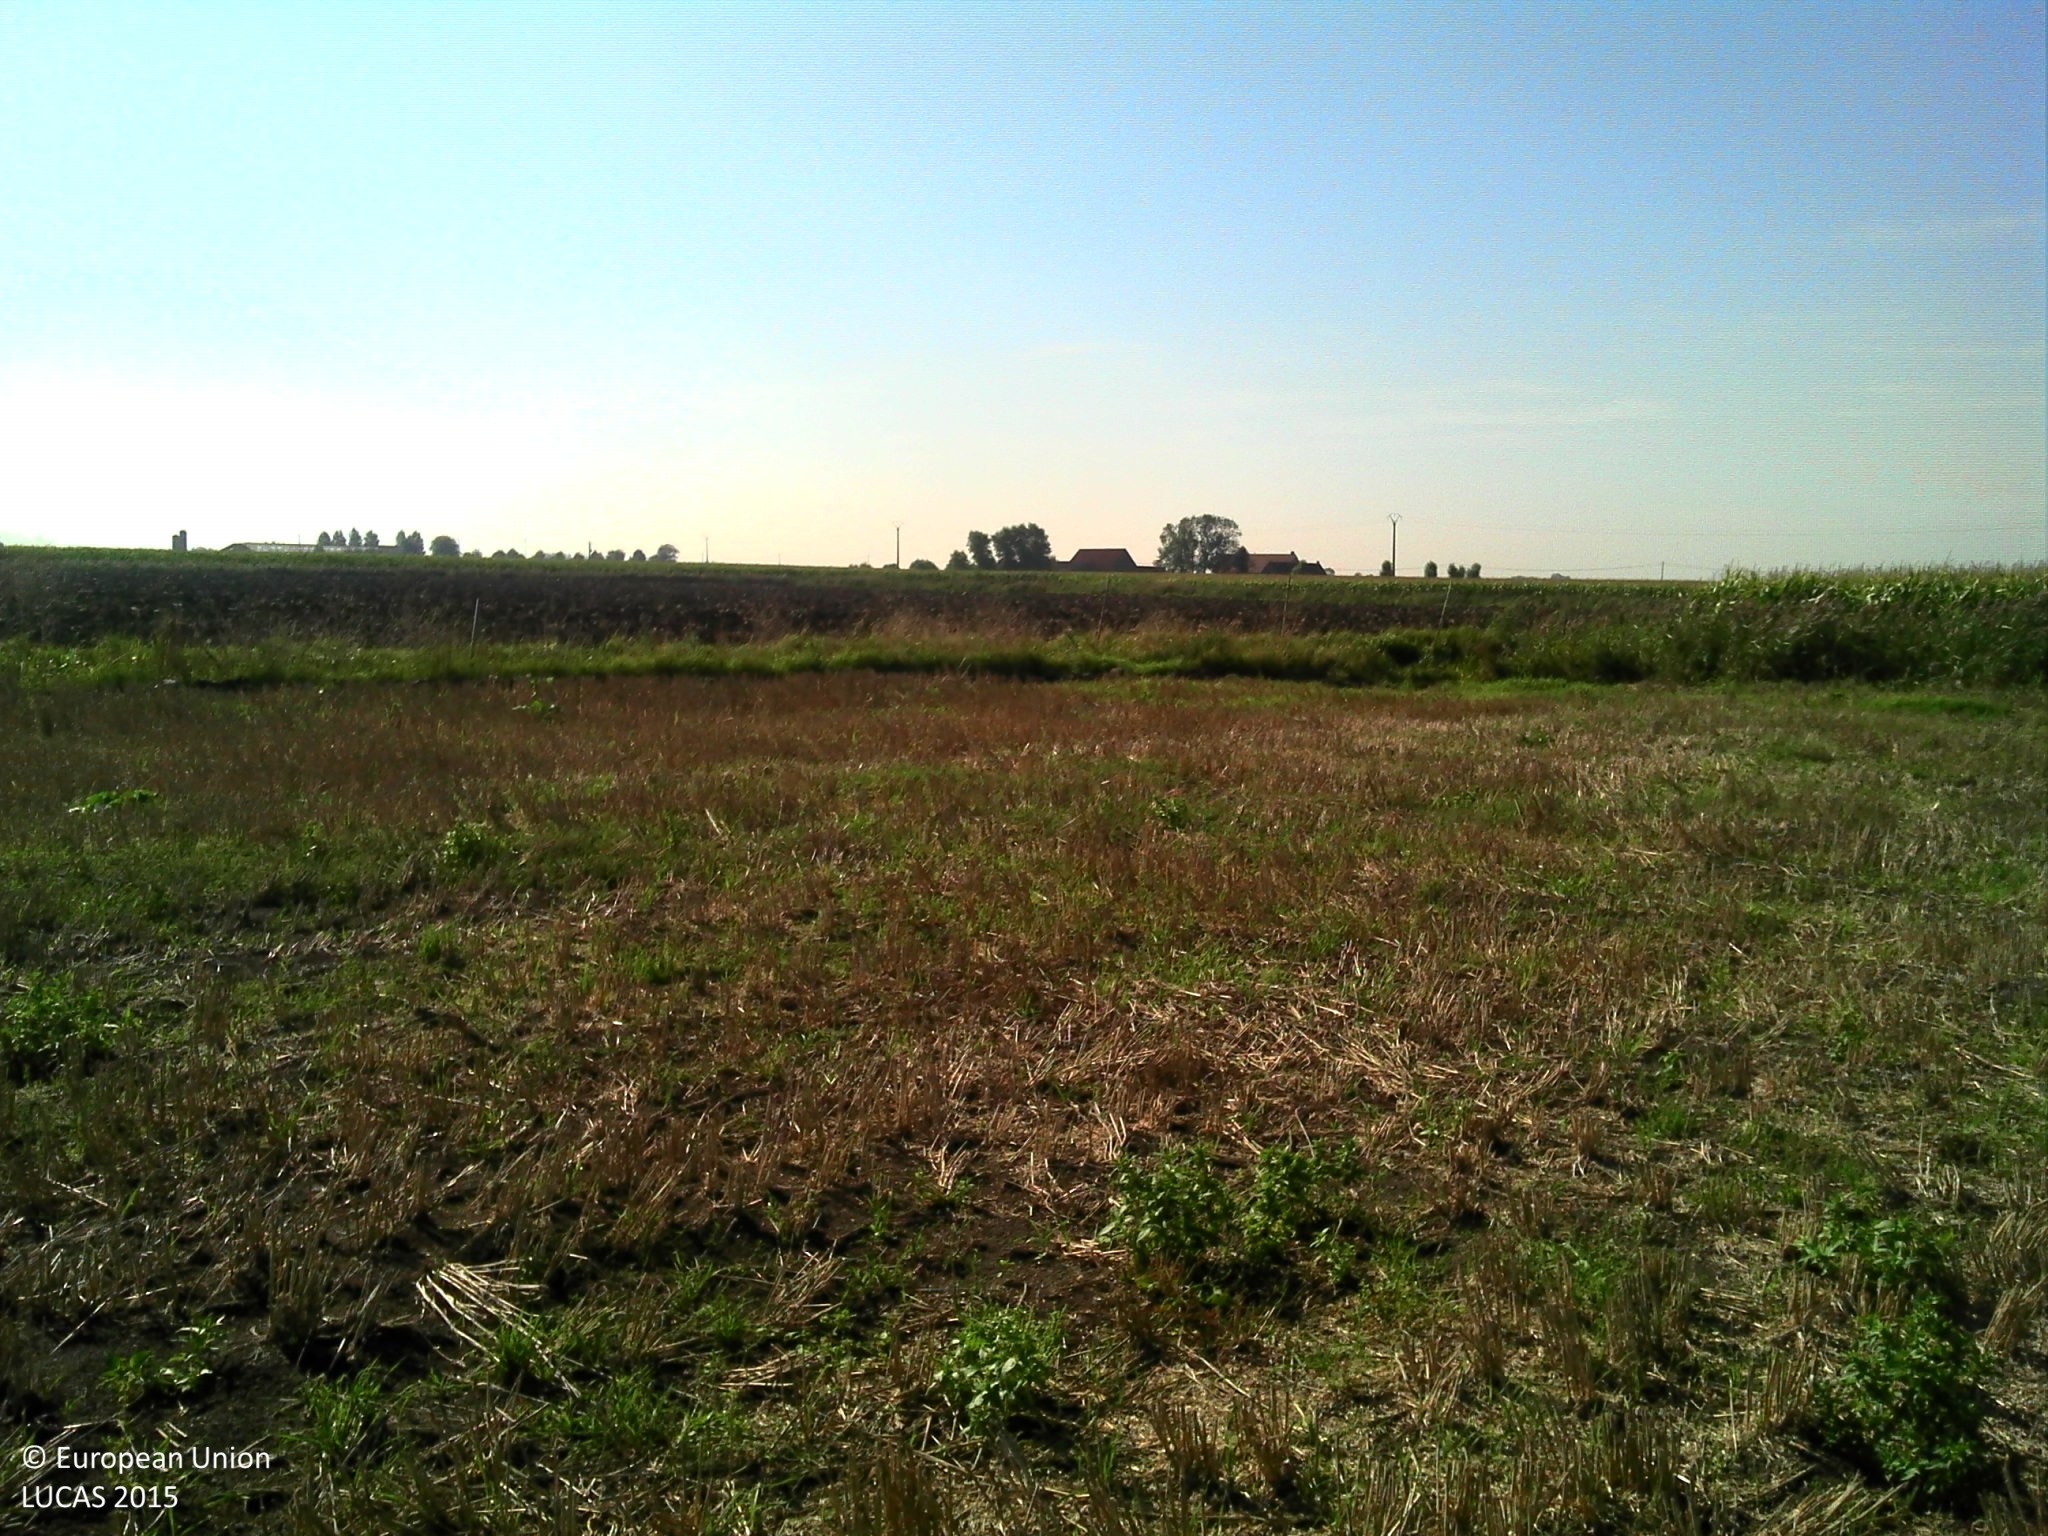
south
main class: Cropland
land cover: Common wheat
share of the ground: 25 - 50 %
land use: Agriculture (excluding fallow land and kitchen gardens)
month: September
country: BE
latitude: 51.0388
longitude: 2.7866
